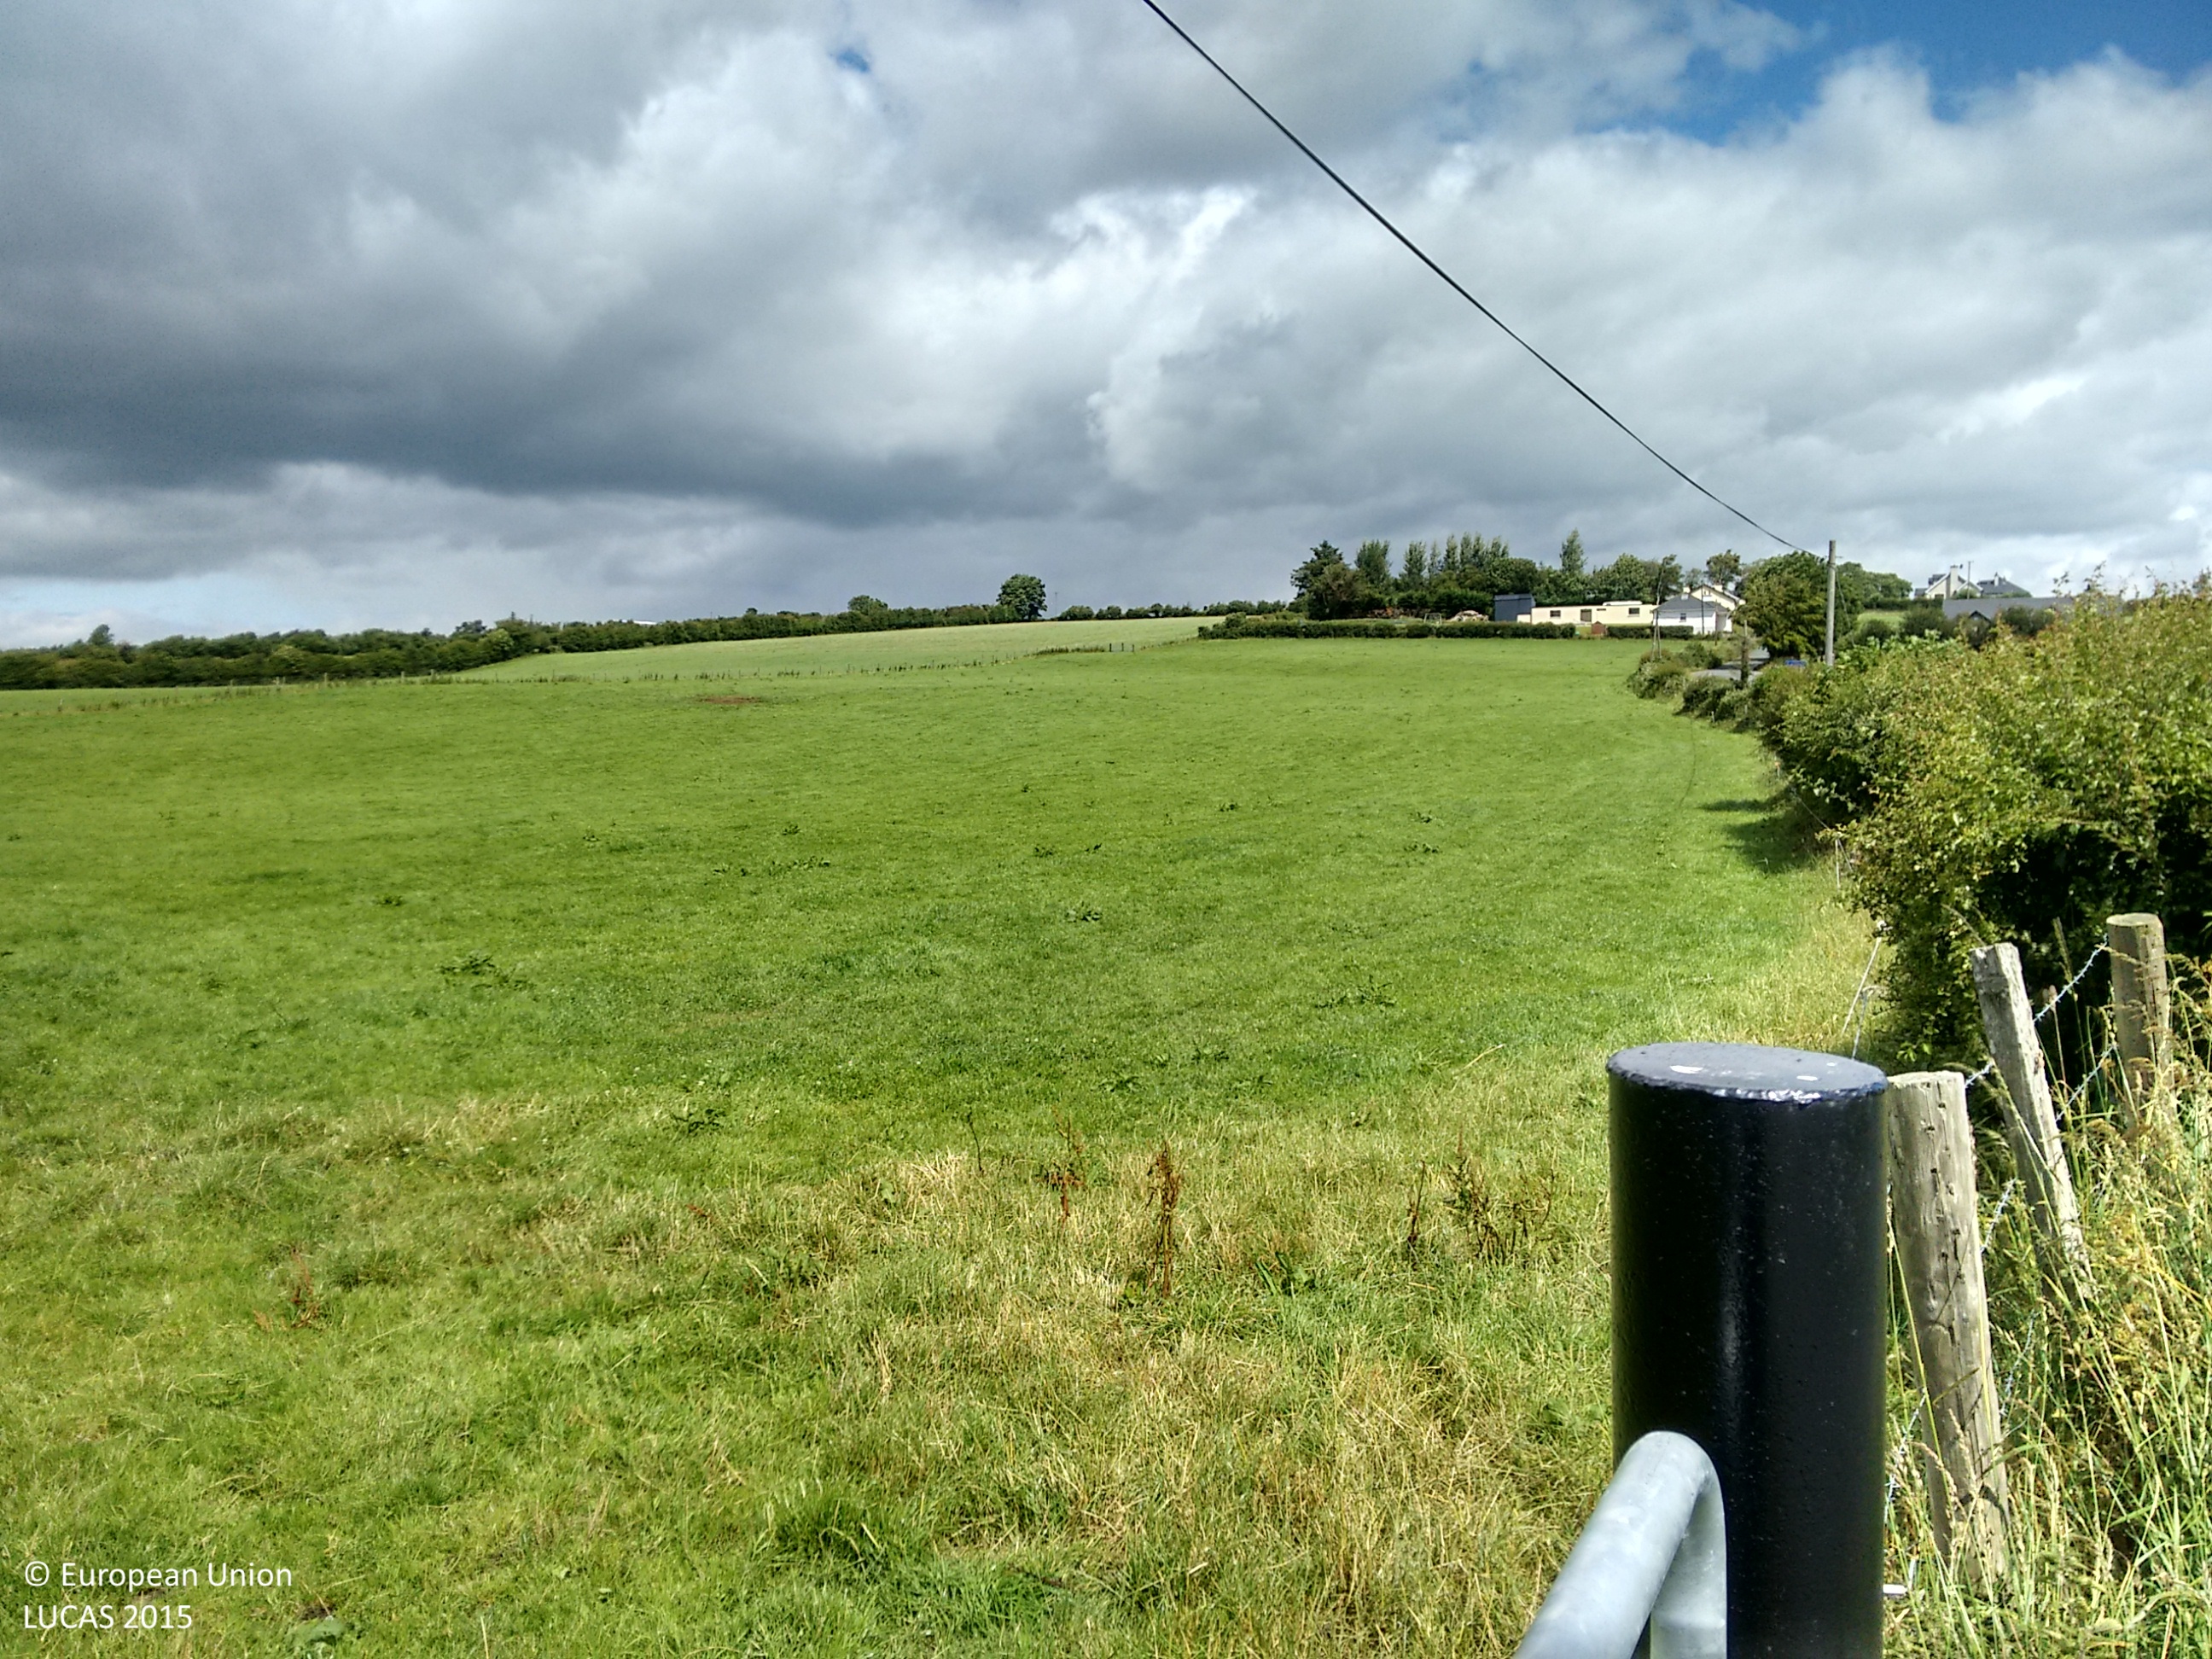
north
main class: Grassland
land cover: Grassland without tree/shrub cover
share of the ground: > 75 %
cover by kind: herbaceous plants 100 %
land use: Agriculture (excluding fallow land and kitchen gardens)
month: July
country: IE
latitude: 52.7646
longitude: -7.4522
